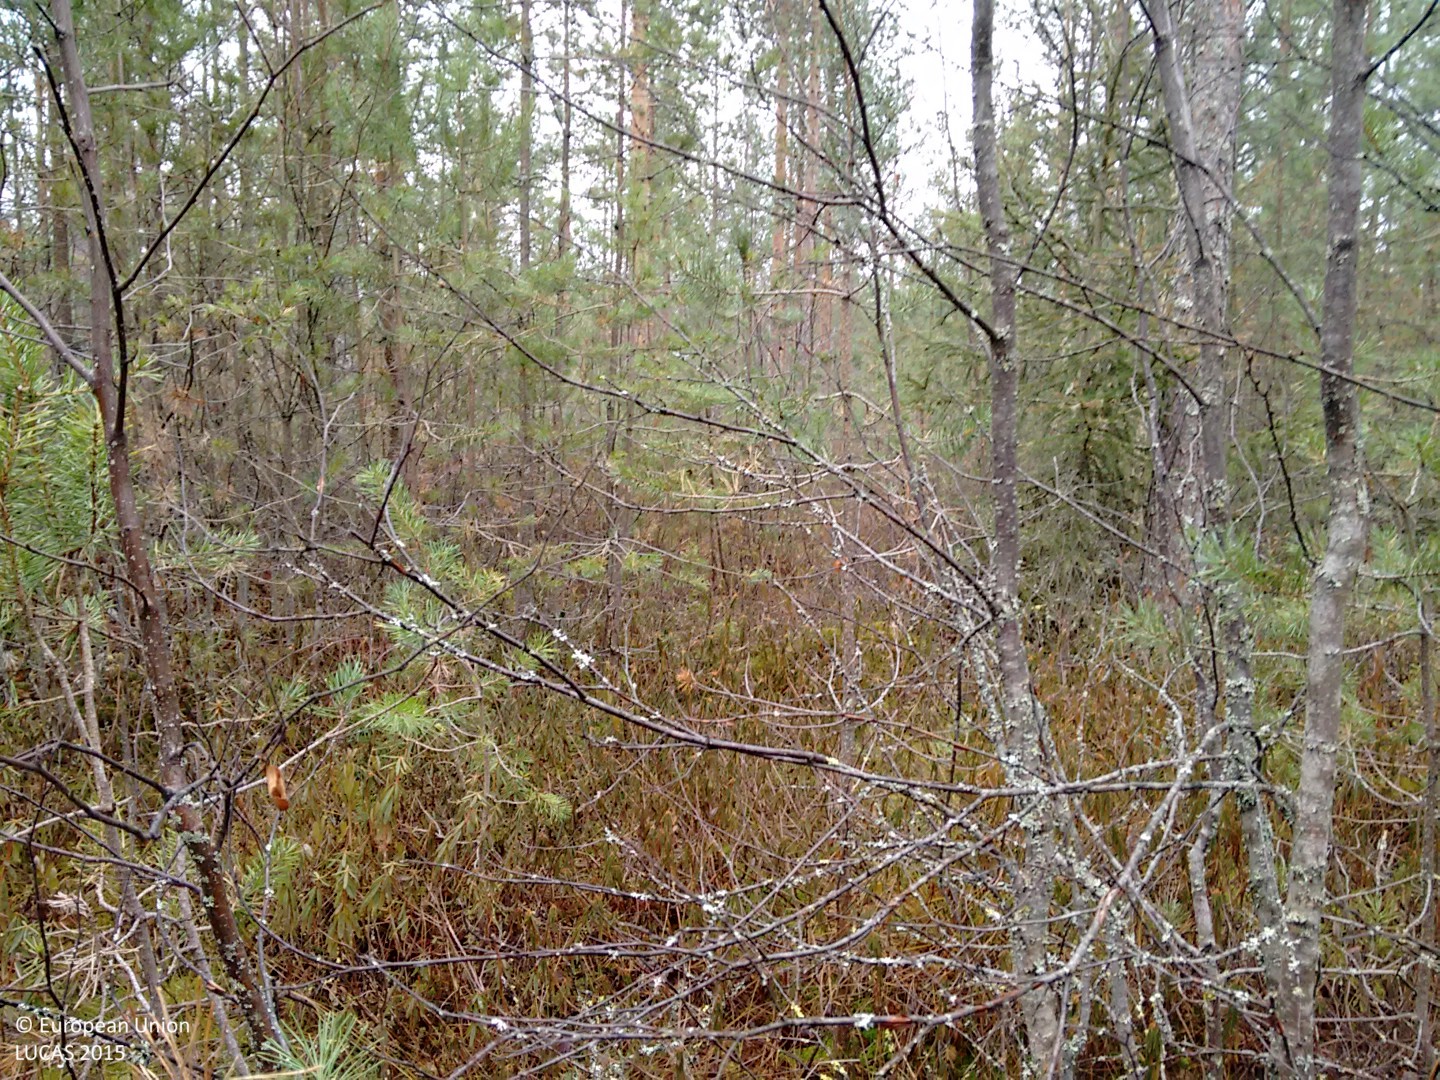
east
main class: Woodland
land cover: Pine dominated coniferous woodland
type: boreal forest
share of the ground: > 75 %
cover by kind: coniferous forest trees 70 %, broadleaved forest trees 10 %, shrubs 10 %, herbaceous plants 5 %, lichens and mosses 5 %
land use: Forestry
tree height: > 5 m
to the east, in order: Ditches and canals; Pine dominated coniferous woodland; Ditches and canals; Pine dominated coniferous woodland; Ditches and canals; Pine dominated coniferous woodland; Ditches and canals; Pine dominated coniferous woodland; Ditches and canals; Pine dominated coniferous woodland; Ditches and canals; Pine dominated mixed woodland; Ditches and canals; Pine dominated mixed woodland; Grassland with sparse tree/shrub cover; Electric lines; Grassland with sparse tree/shrub cover; Pine dominated mixed woodland; Ditches and canals; Pine dominated mixed woodland; Ditches and canals; Pine dominated mixed woodland; Broadleaved woodland
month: October
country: FI
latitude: 64.4819
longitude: 25.2938
